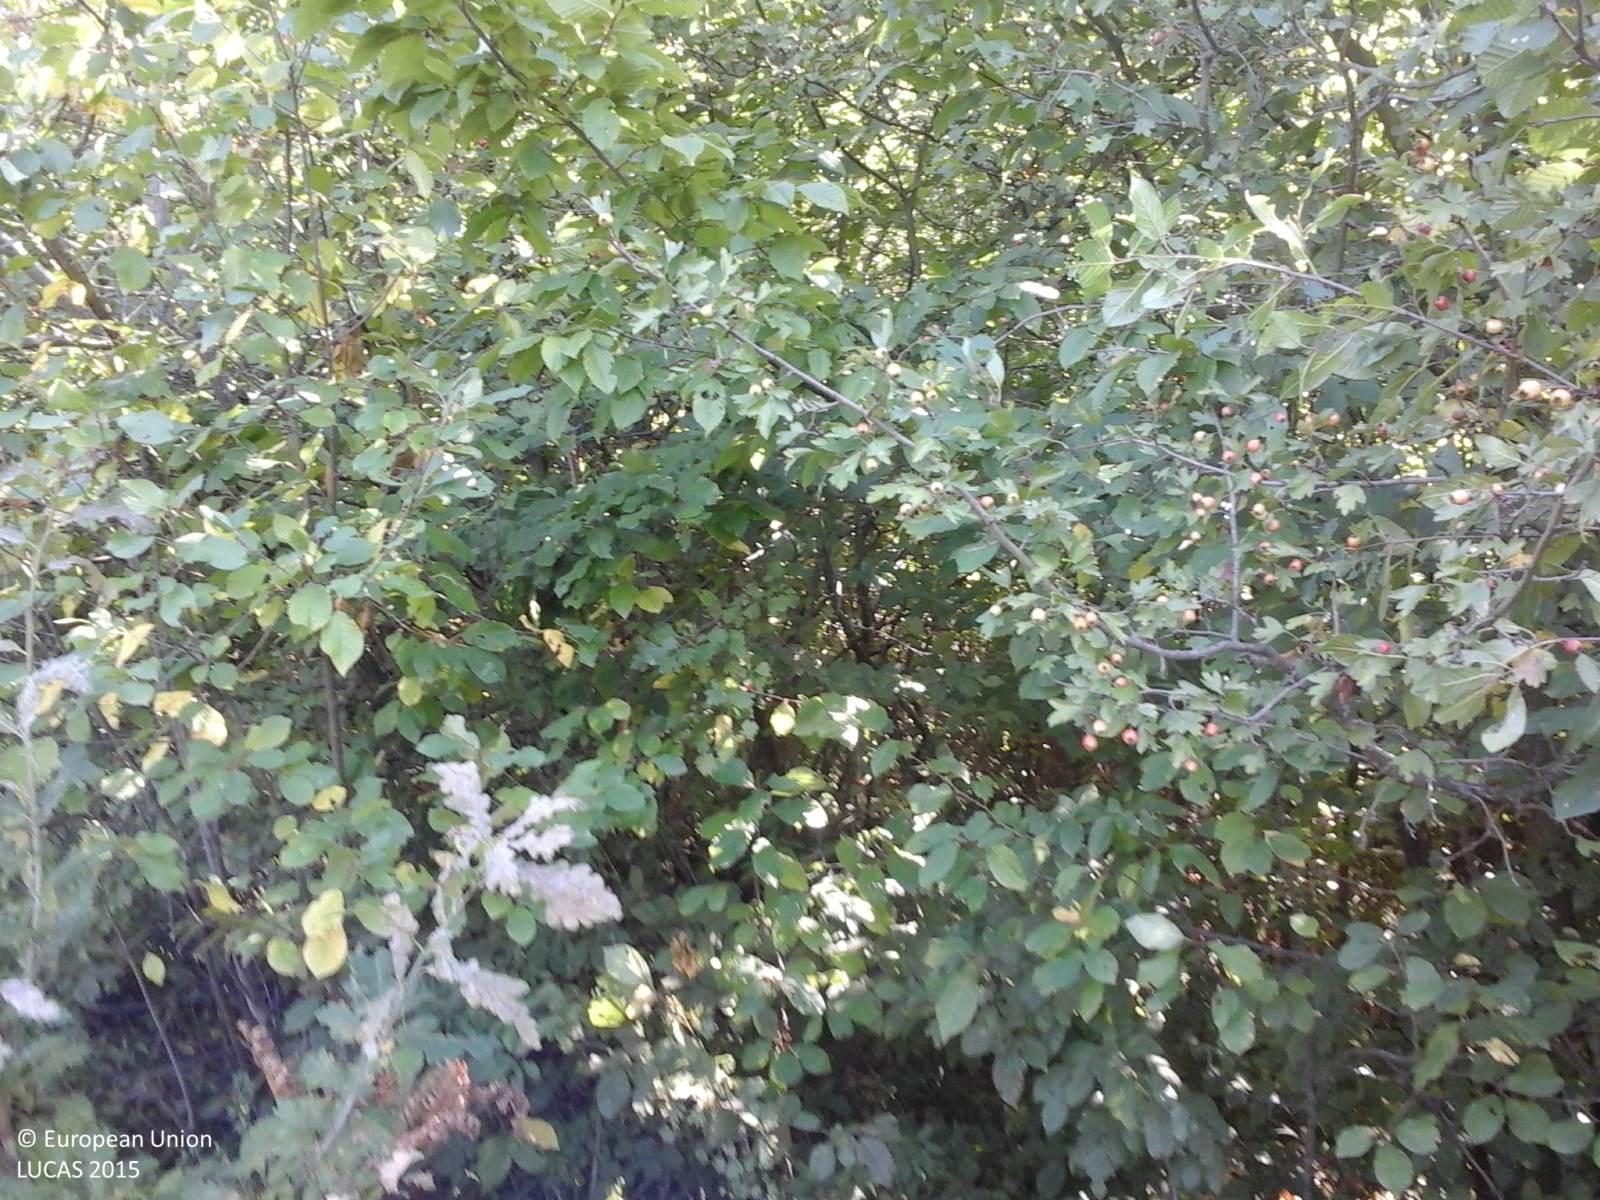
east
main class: Woodland
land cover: Broadleaved woodland
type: beech forest
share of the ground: > 75 %
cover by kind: broadleaved forest trees 100 %
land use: Forestry
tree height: > 5 m
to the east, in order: Broadleaved woodland; Grassland with sparse tree/shrub cover; Broadleaved woodland
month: September
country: RO
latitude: 47.3717
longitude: 23.4881
